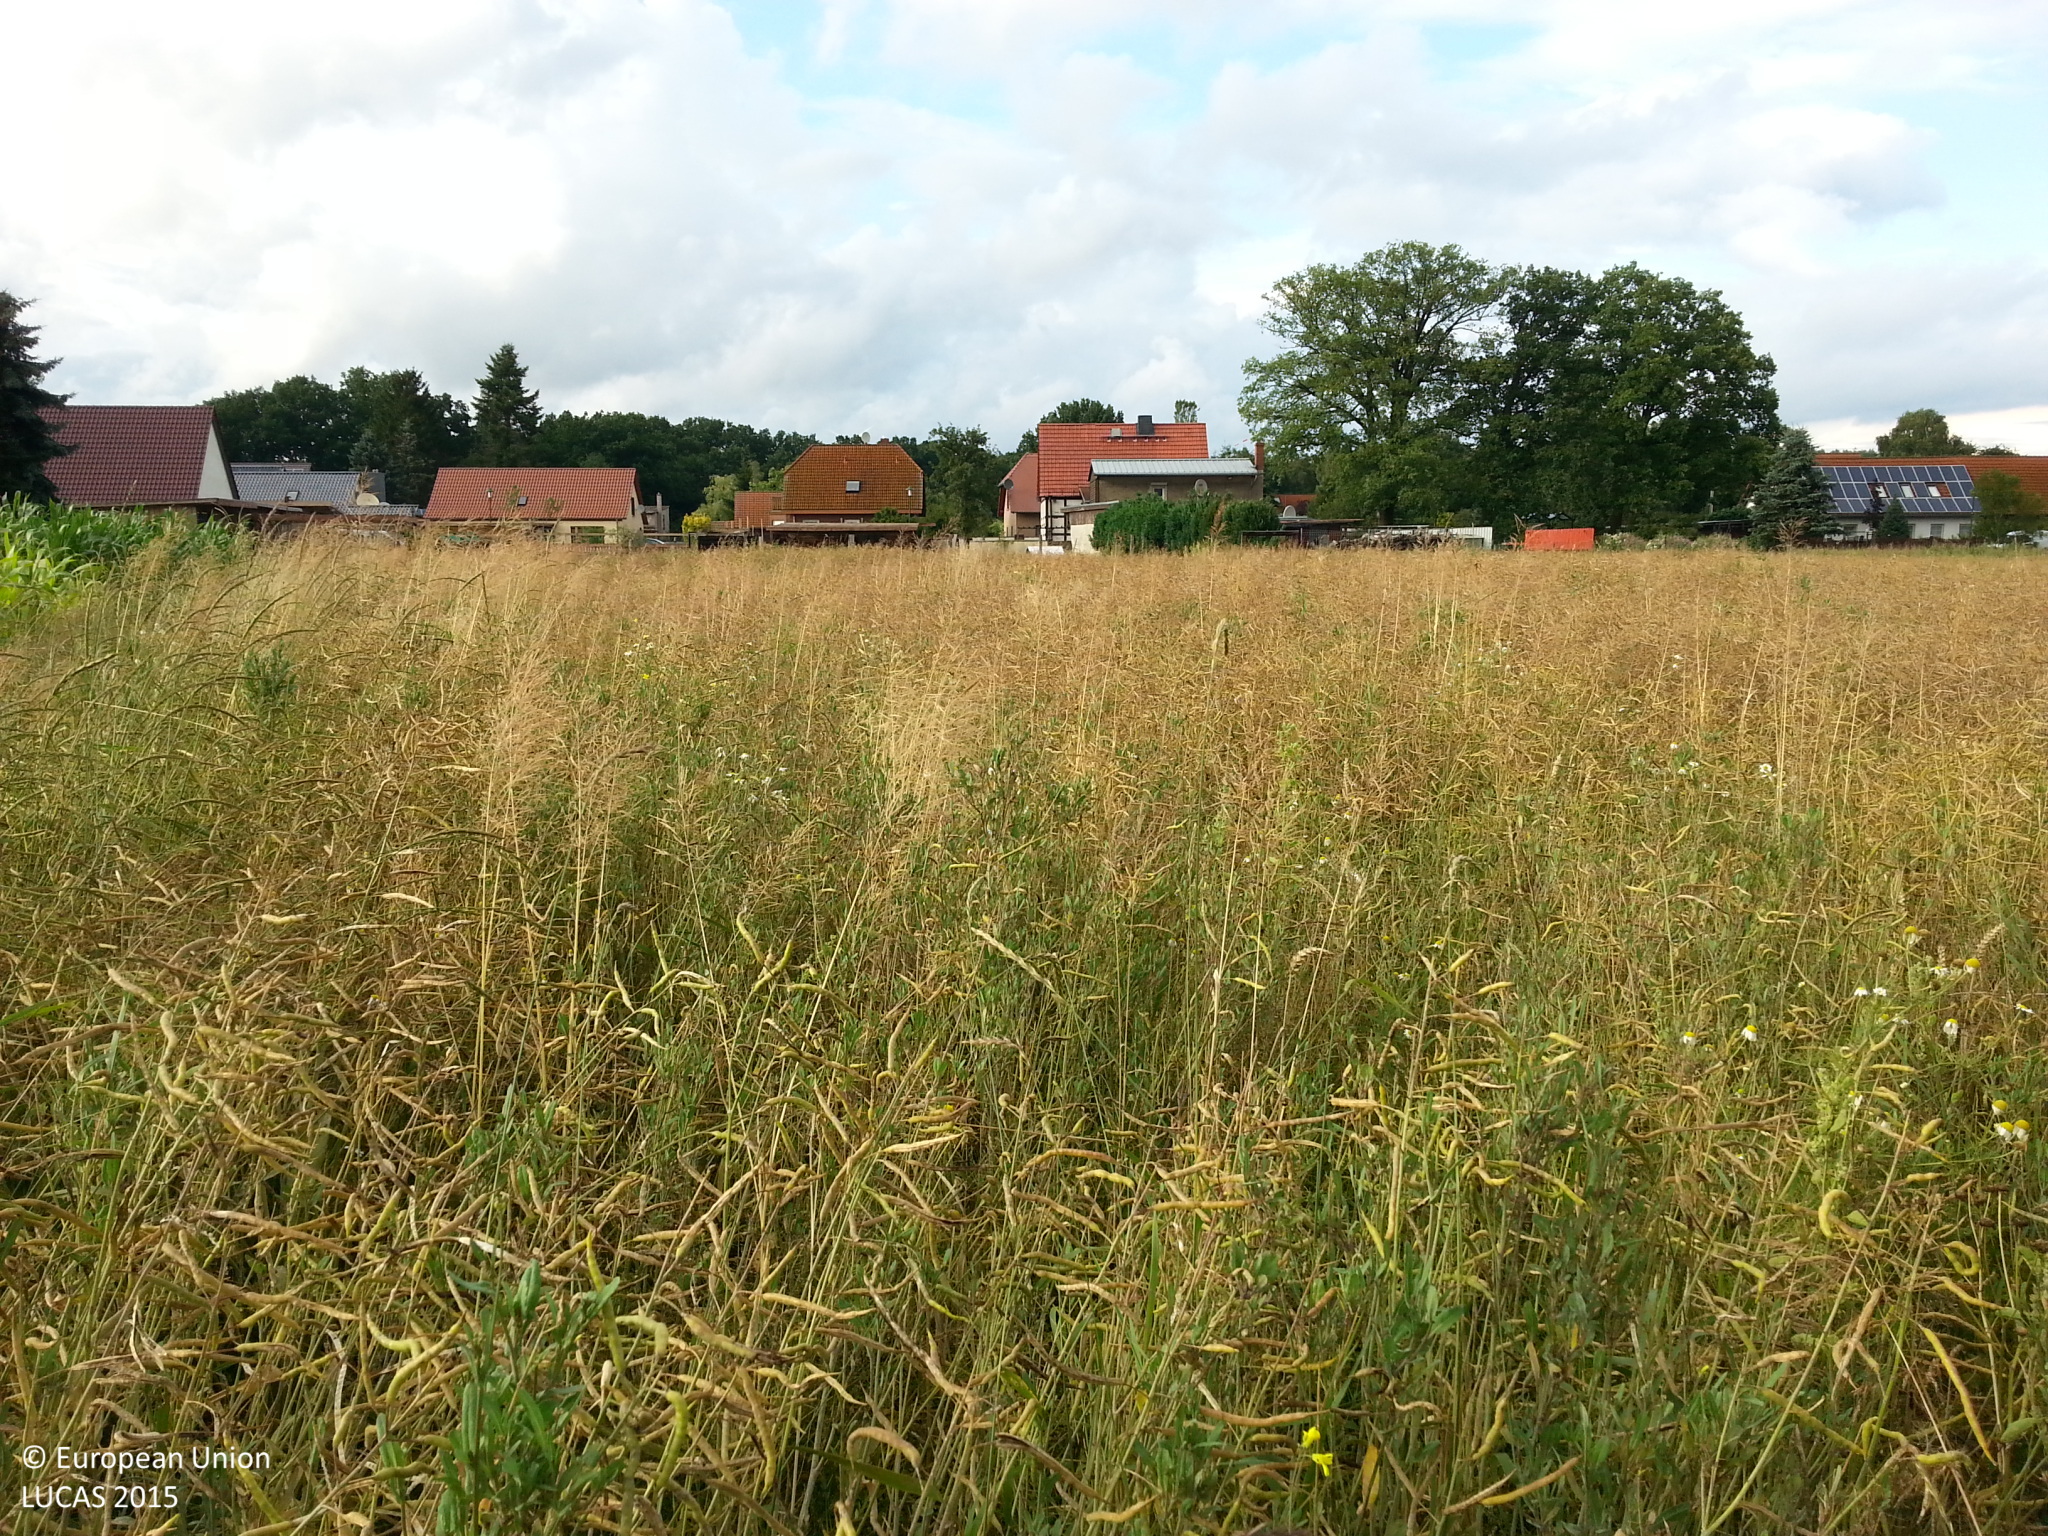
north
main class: Cropland
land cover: Rape and turnip rape
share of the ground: > 75 %
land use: Agriculture (excluding fallow land and kitchen gardens)
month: July
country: DE
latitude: 53.1257
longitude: 12.4353
